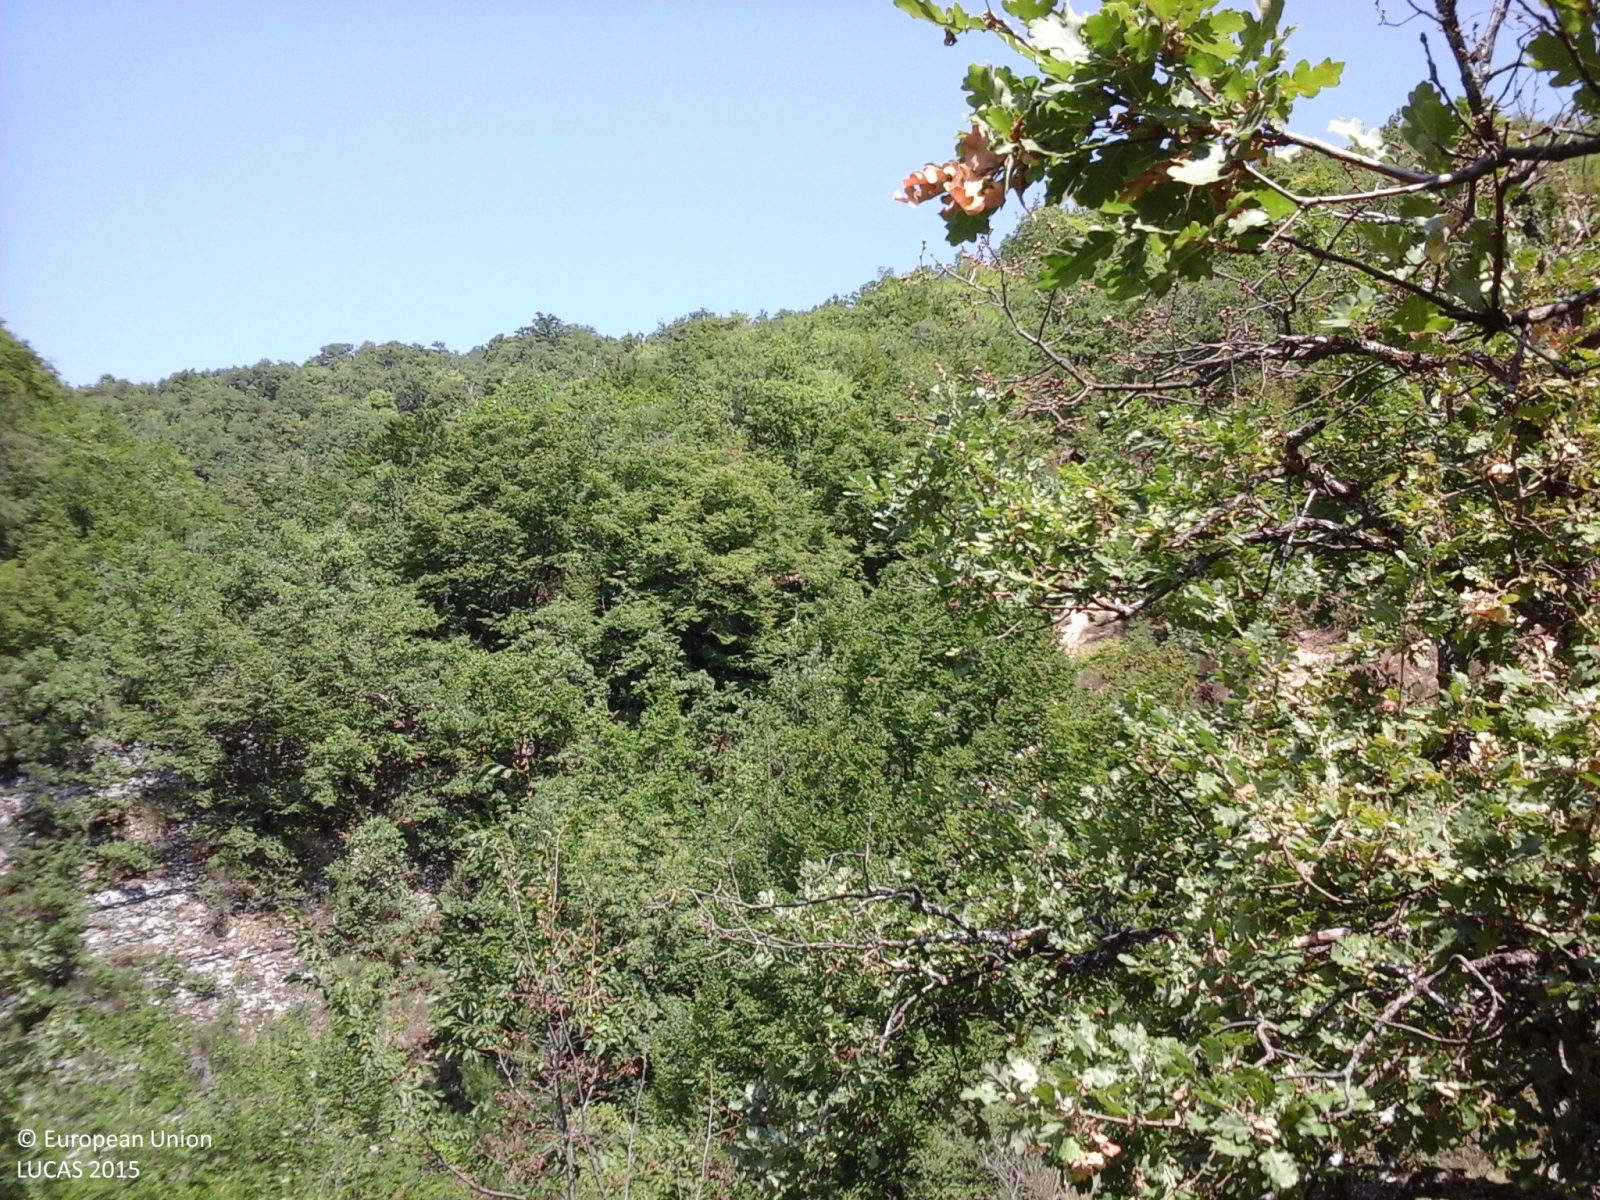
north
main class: Woodland
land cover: Broadleaved woodland
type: thermophilous deciduous forest
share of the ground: > 75 %
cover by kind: broadleaved forest trees 100 %
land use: Forestry
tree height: < 5 m
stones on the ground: > 50 %
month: August
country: IT
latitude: 42.9667
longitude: 13.1419
